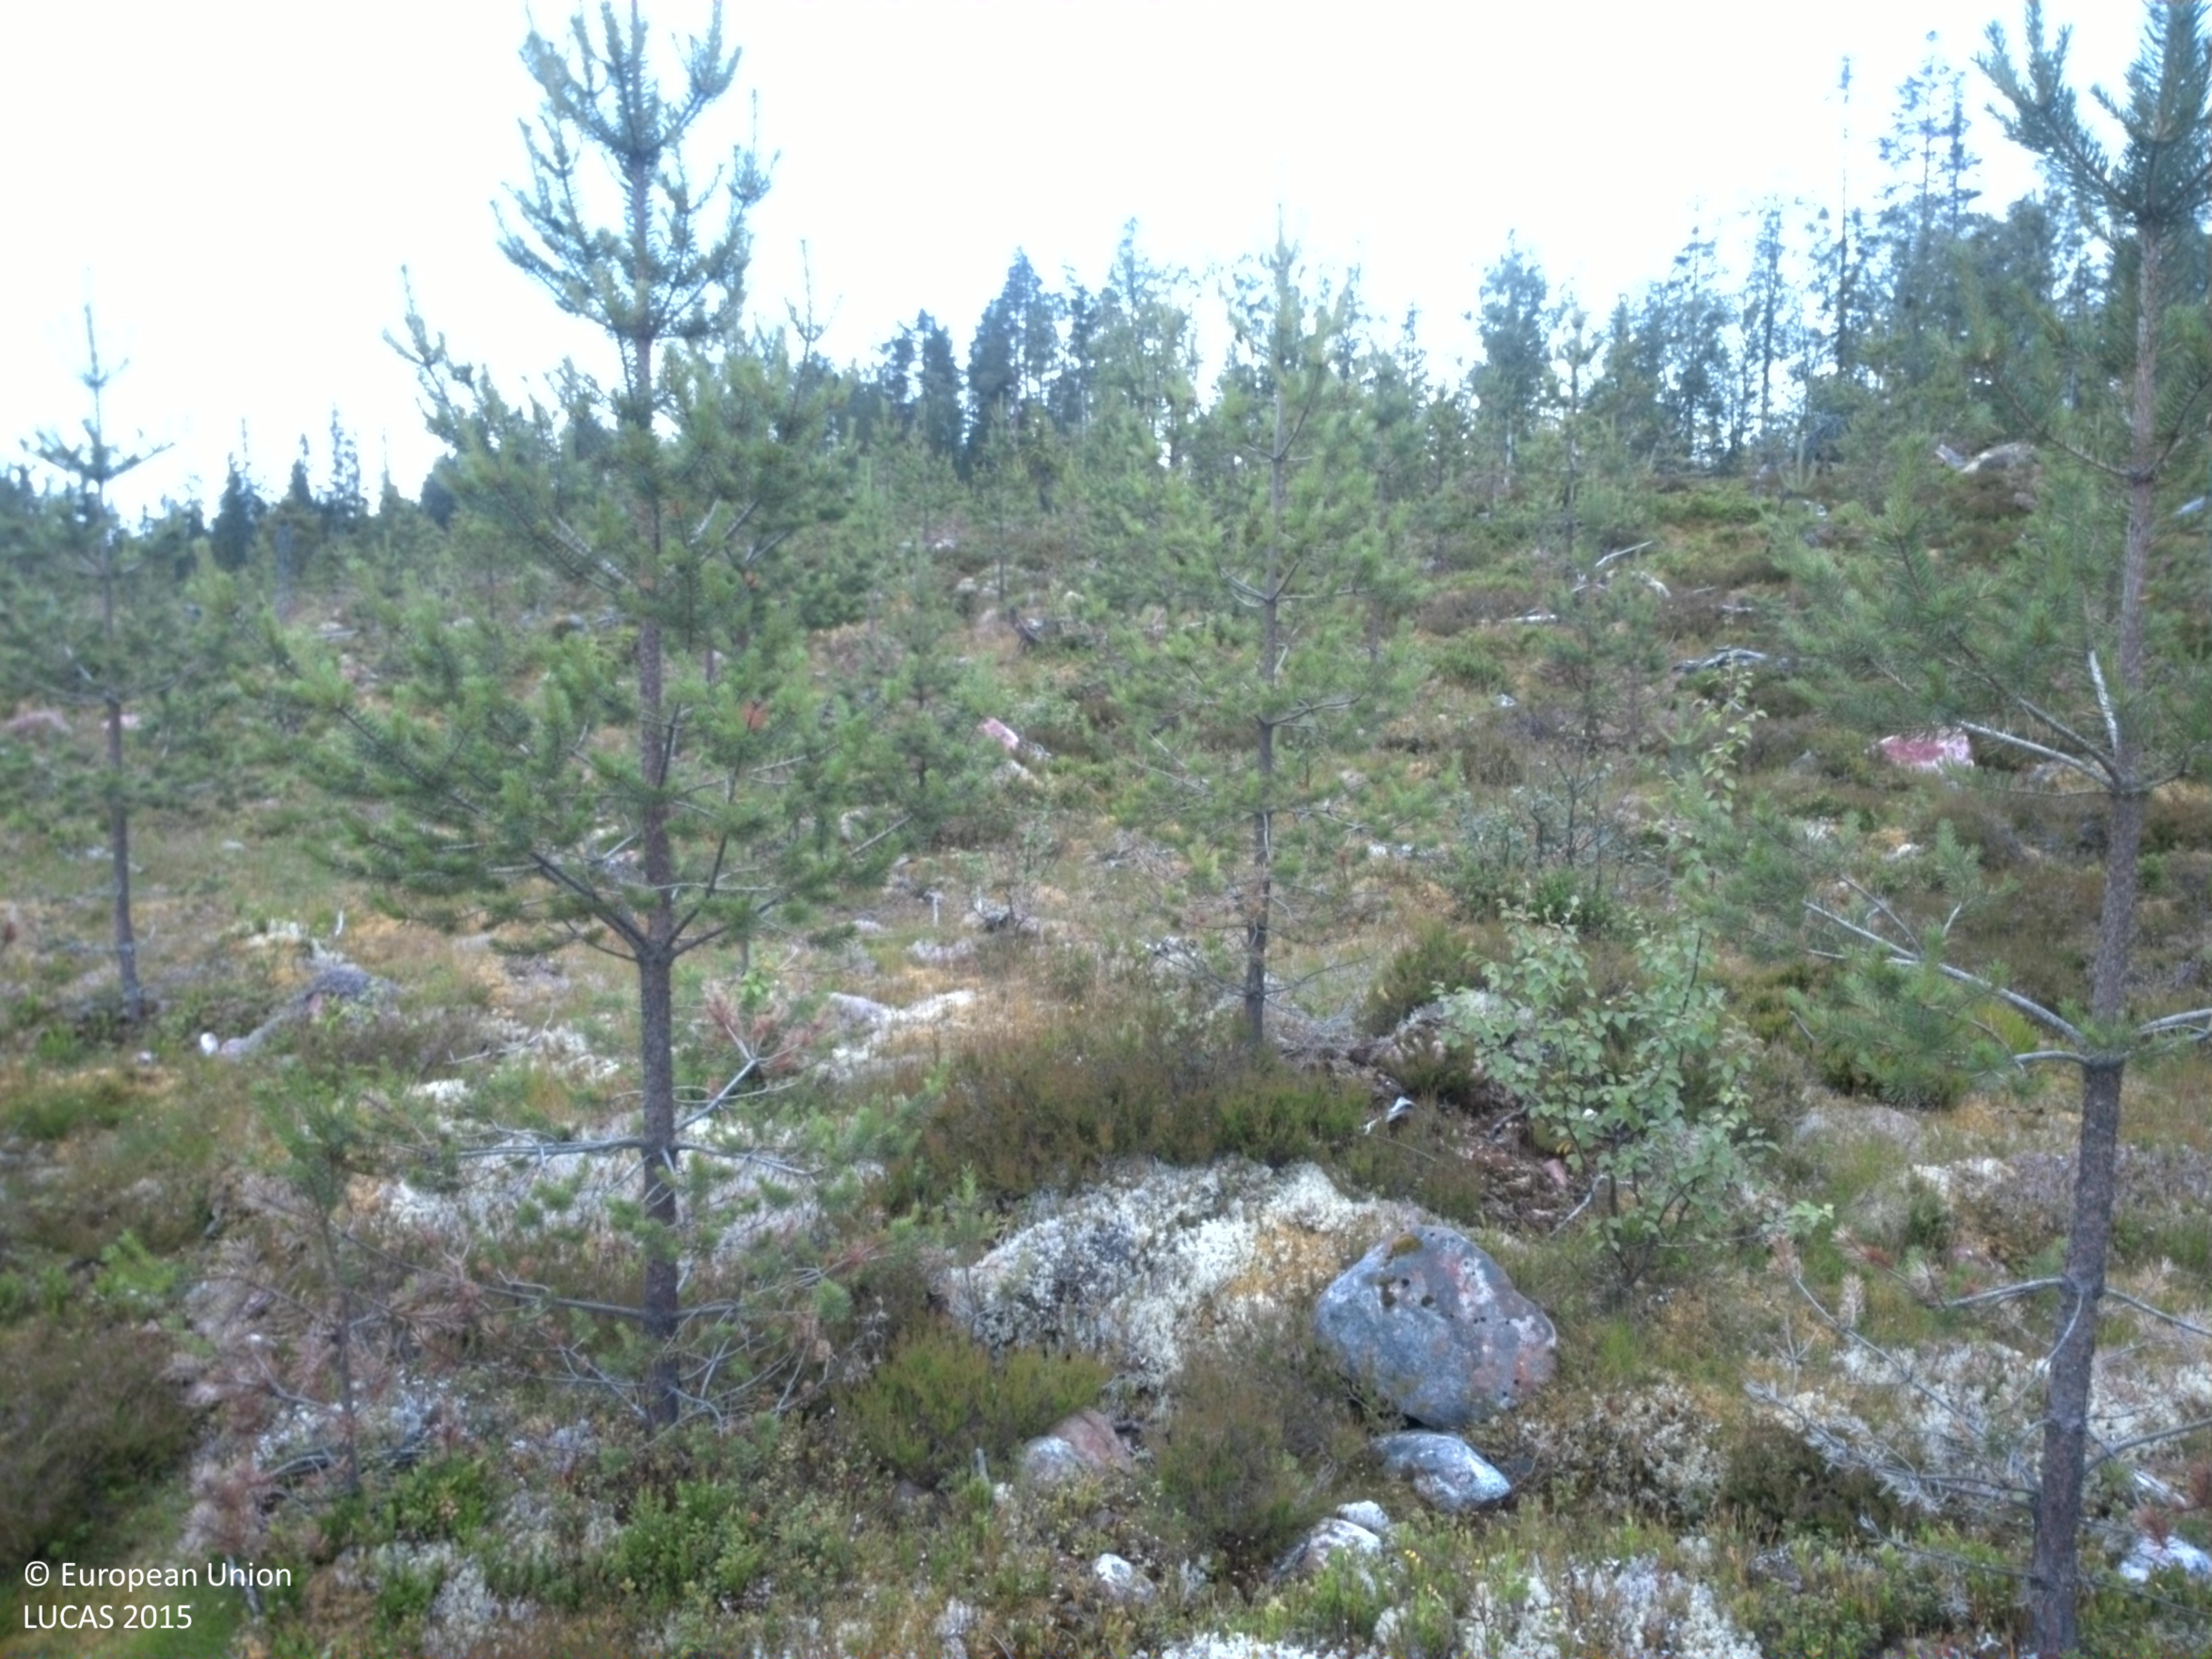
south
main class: Woodland
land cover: Pine dominated coniferous woodland
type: boreal forest
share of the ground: 10 - 25 %
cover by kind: shrubs 40 %, coniferous forest trees 20 %, consolidated bare surface 20 %, lichens and mosses 10 %, broadleaved forest trees 5 %, herbaceous plants 5 %
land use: Forestry
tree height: < 5 m
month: August
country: SE
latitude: 61.5762
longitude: 14.2979
